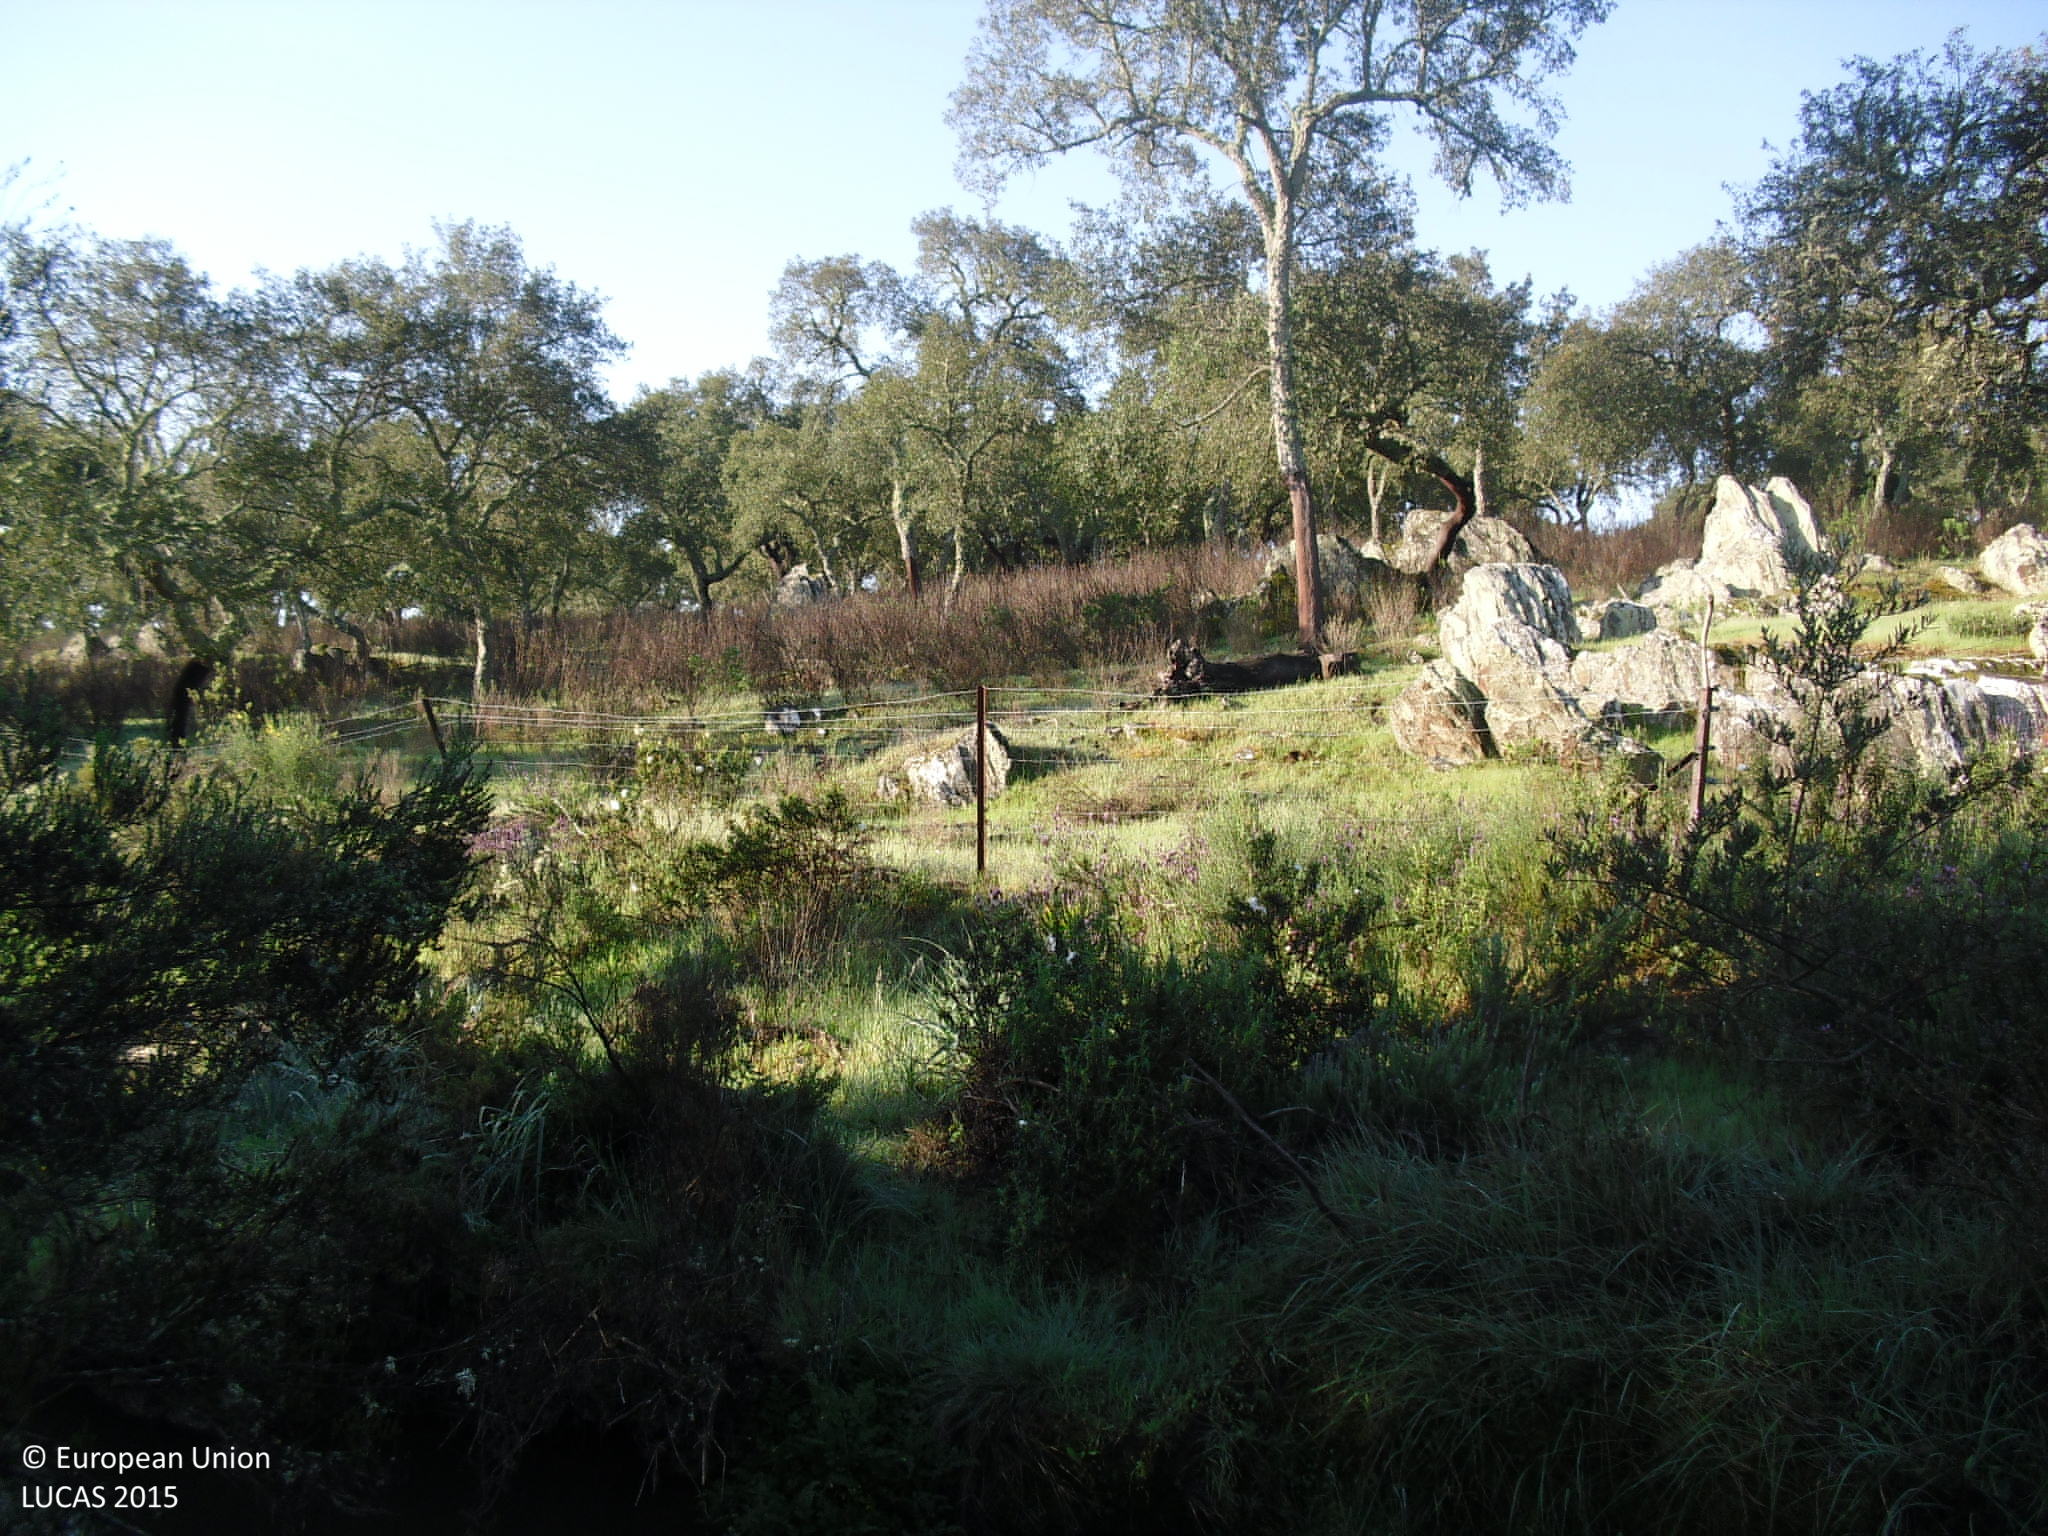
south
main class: Woodland
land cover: Broadleaved woodland
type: broadleaved evergreen forest
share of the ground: 25 - 50 %
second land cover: Grassland without tree/shrub cover
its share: > 75 %
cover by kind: herbaceous plants 60 %, broadleaved forest trees 30 %, shrubs 10 %
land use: Forestry
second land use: Agriculture (excluding fallow land and kitchen gardens)
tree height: > 5 m
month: April
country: ES
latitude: 39.6418
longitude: -7.4931
